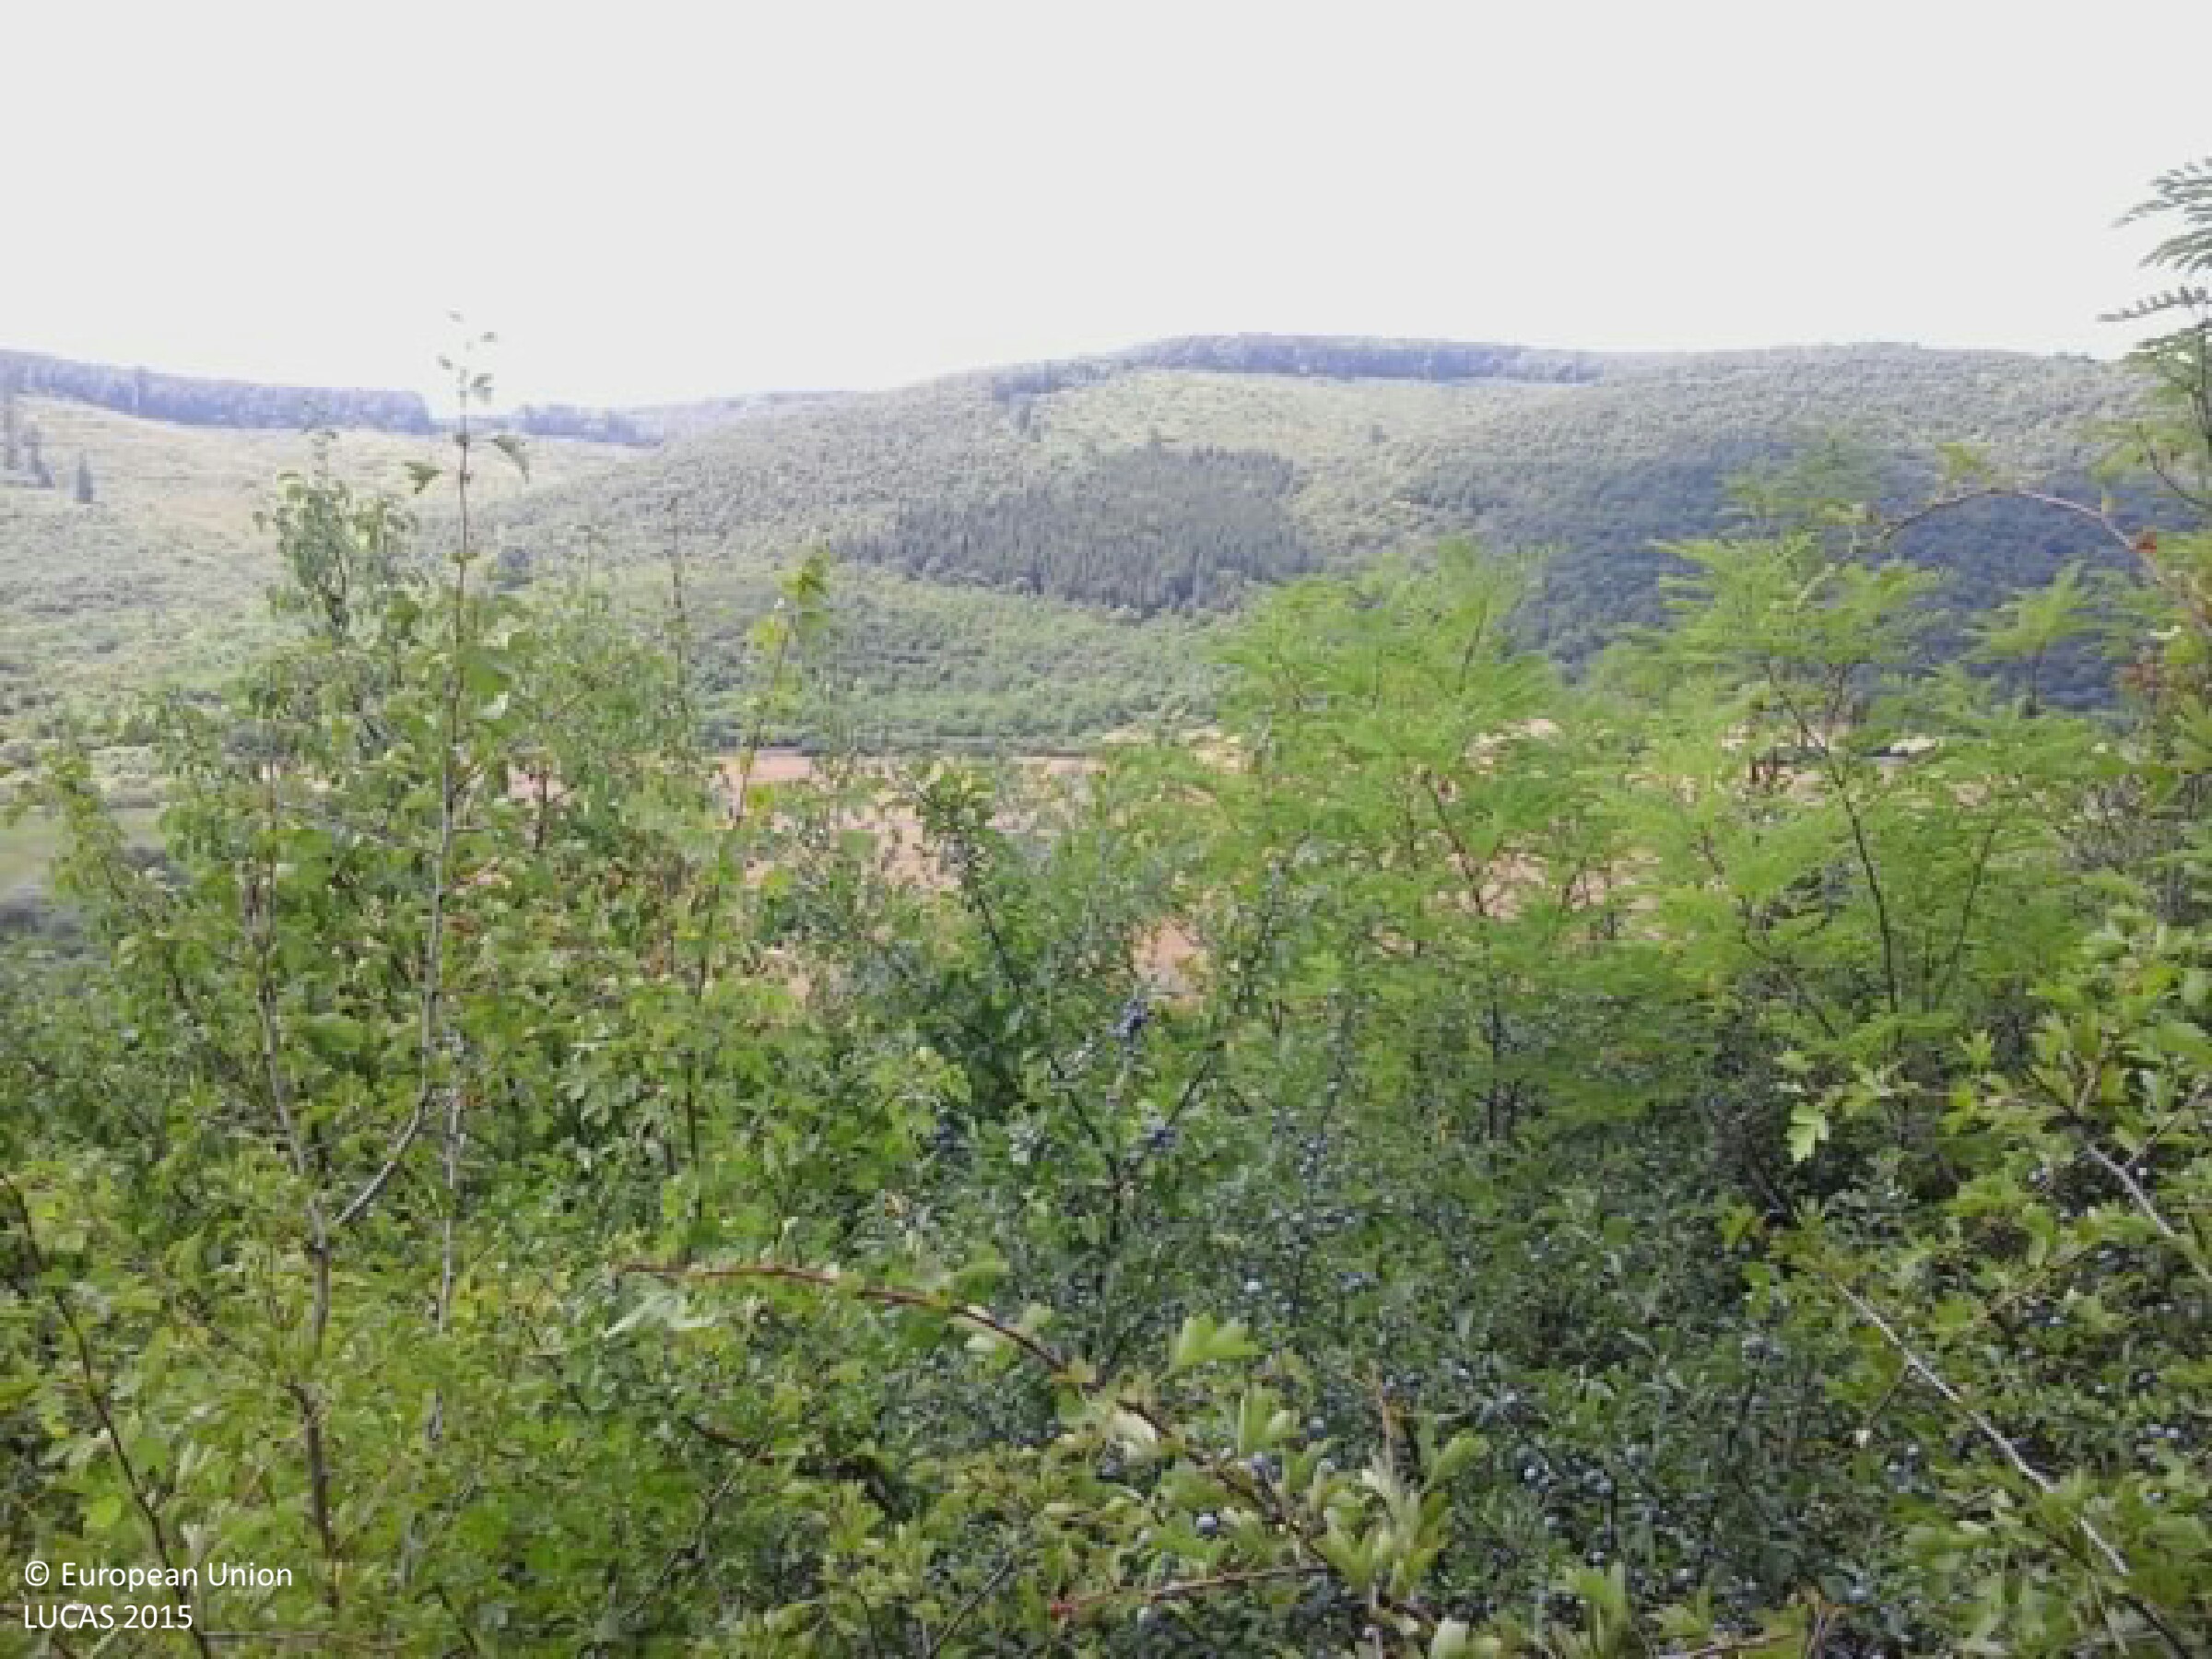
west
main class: Shrubland
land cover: Shrubland with sparse tree cover
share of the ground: > 75 %
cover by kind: shrubs 95 %, broadleaved forest trees 5 %
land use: Semi-natural and natural areas not in use
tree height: < 5 m
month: July
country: HU
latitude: 48.3509
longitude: 20.7379
